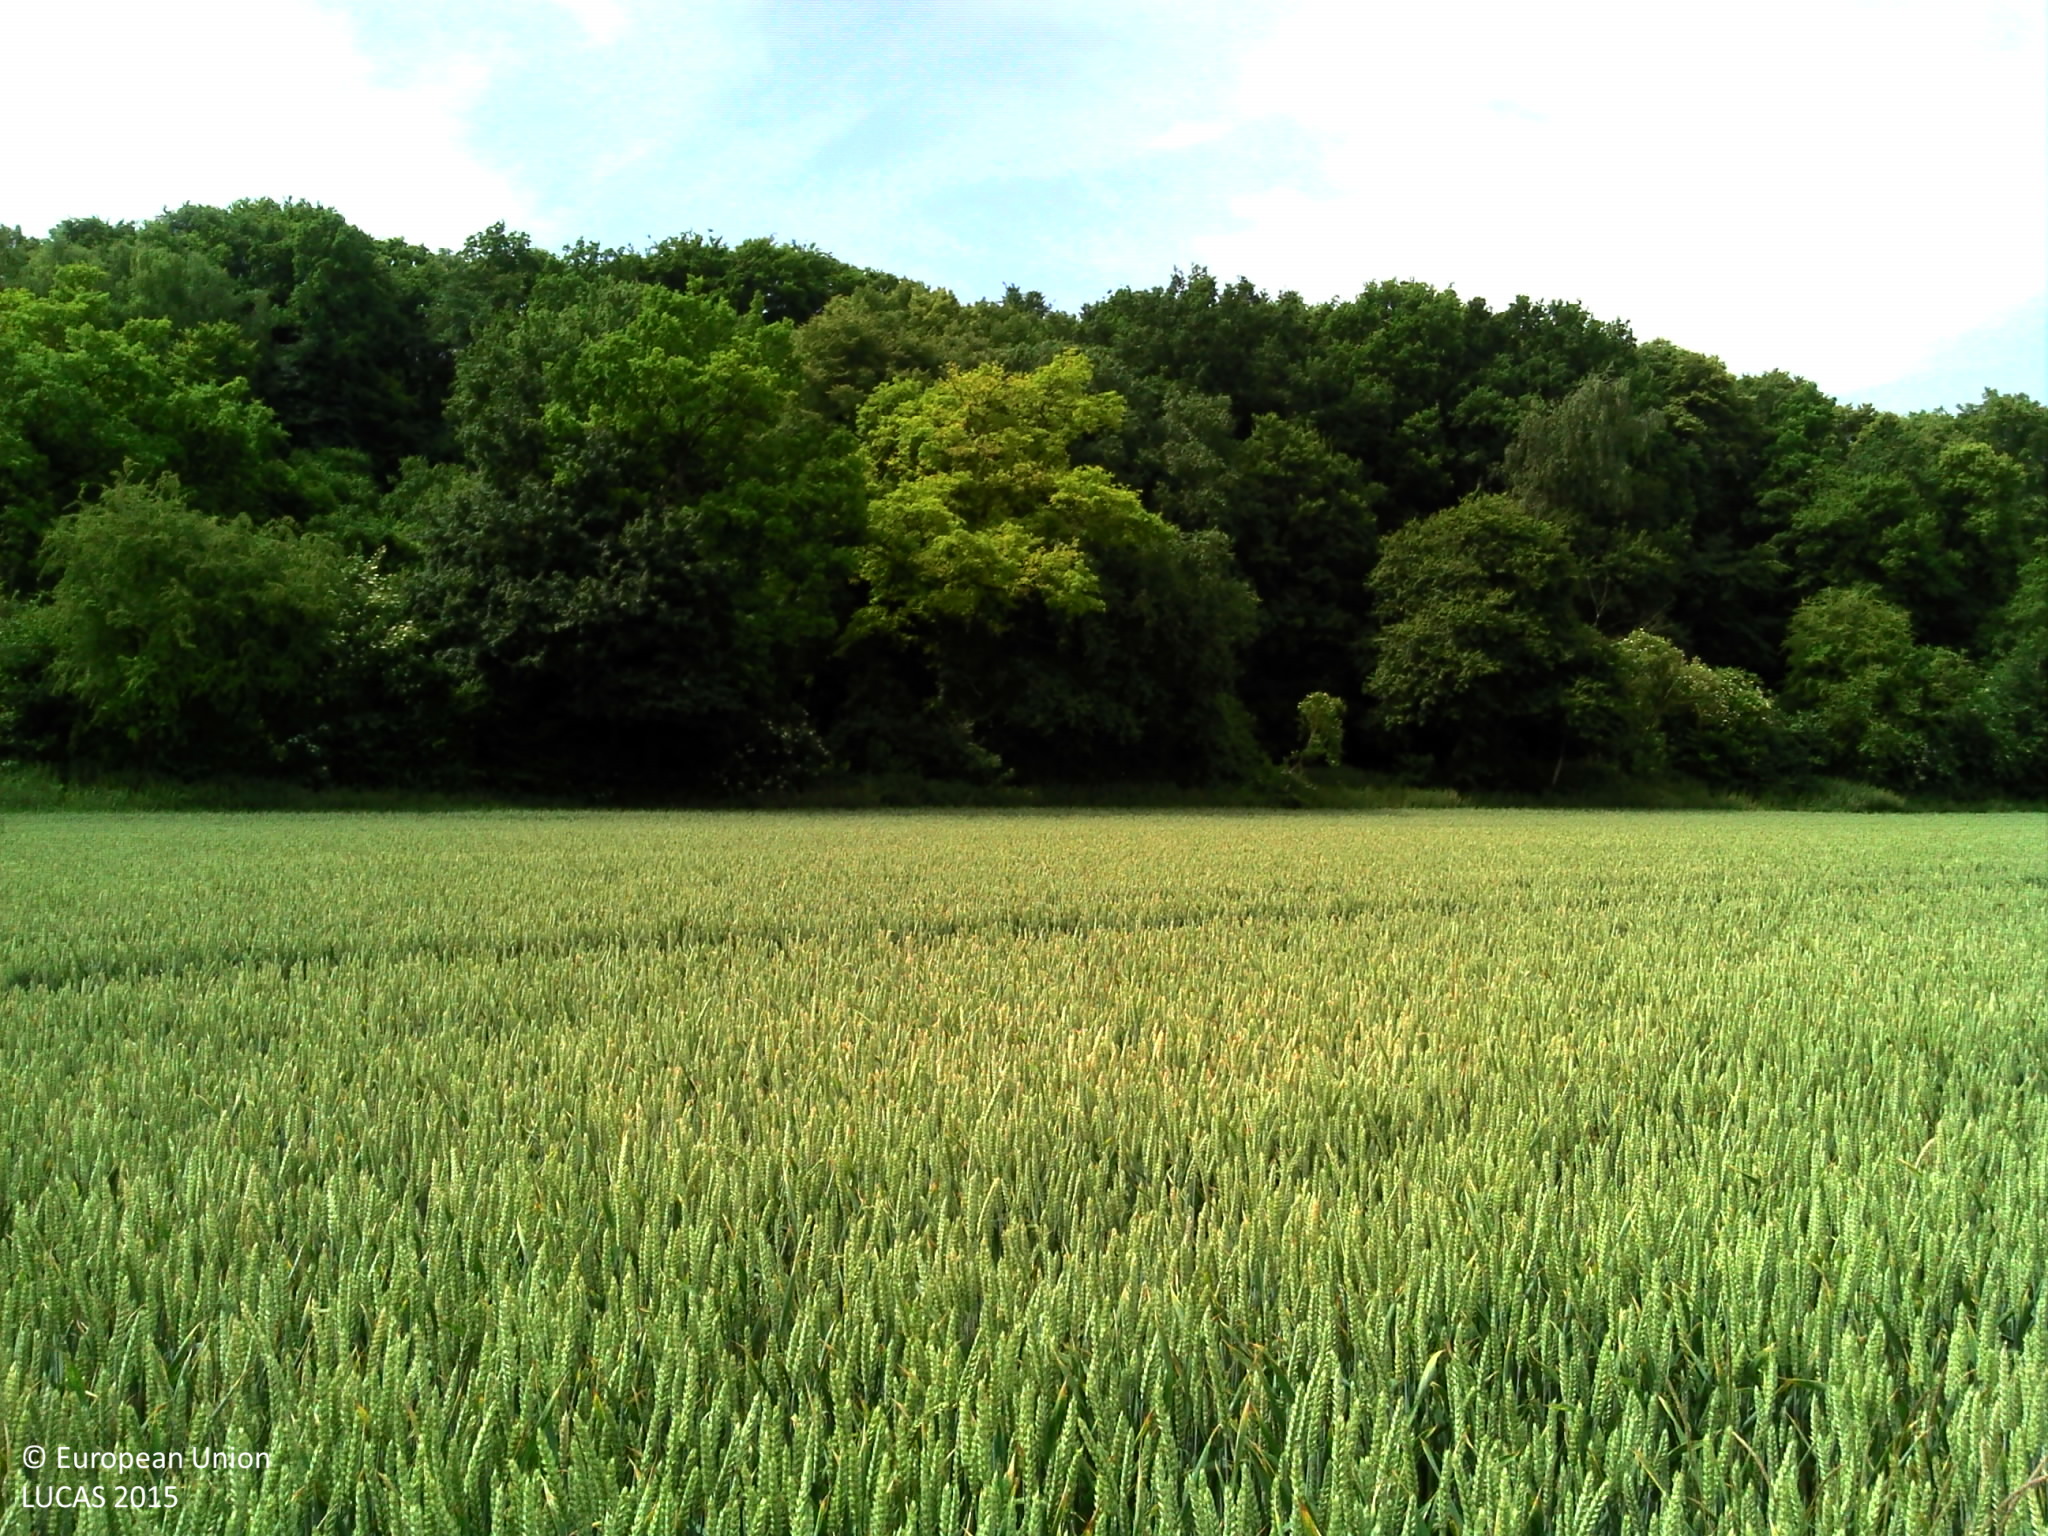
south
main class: Cropland
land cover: Common wheat
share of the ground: > 75 %
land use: Agriculture (excluding fallow land and kitchen gardens)
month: June
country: FR
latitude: 49.6705
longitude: 2.2964
